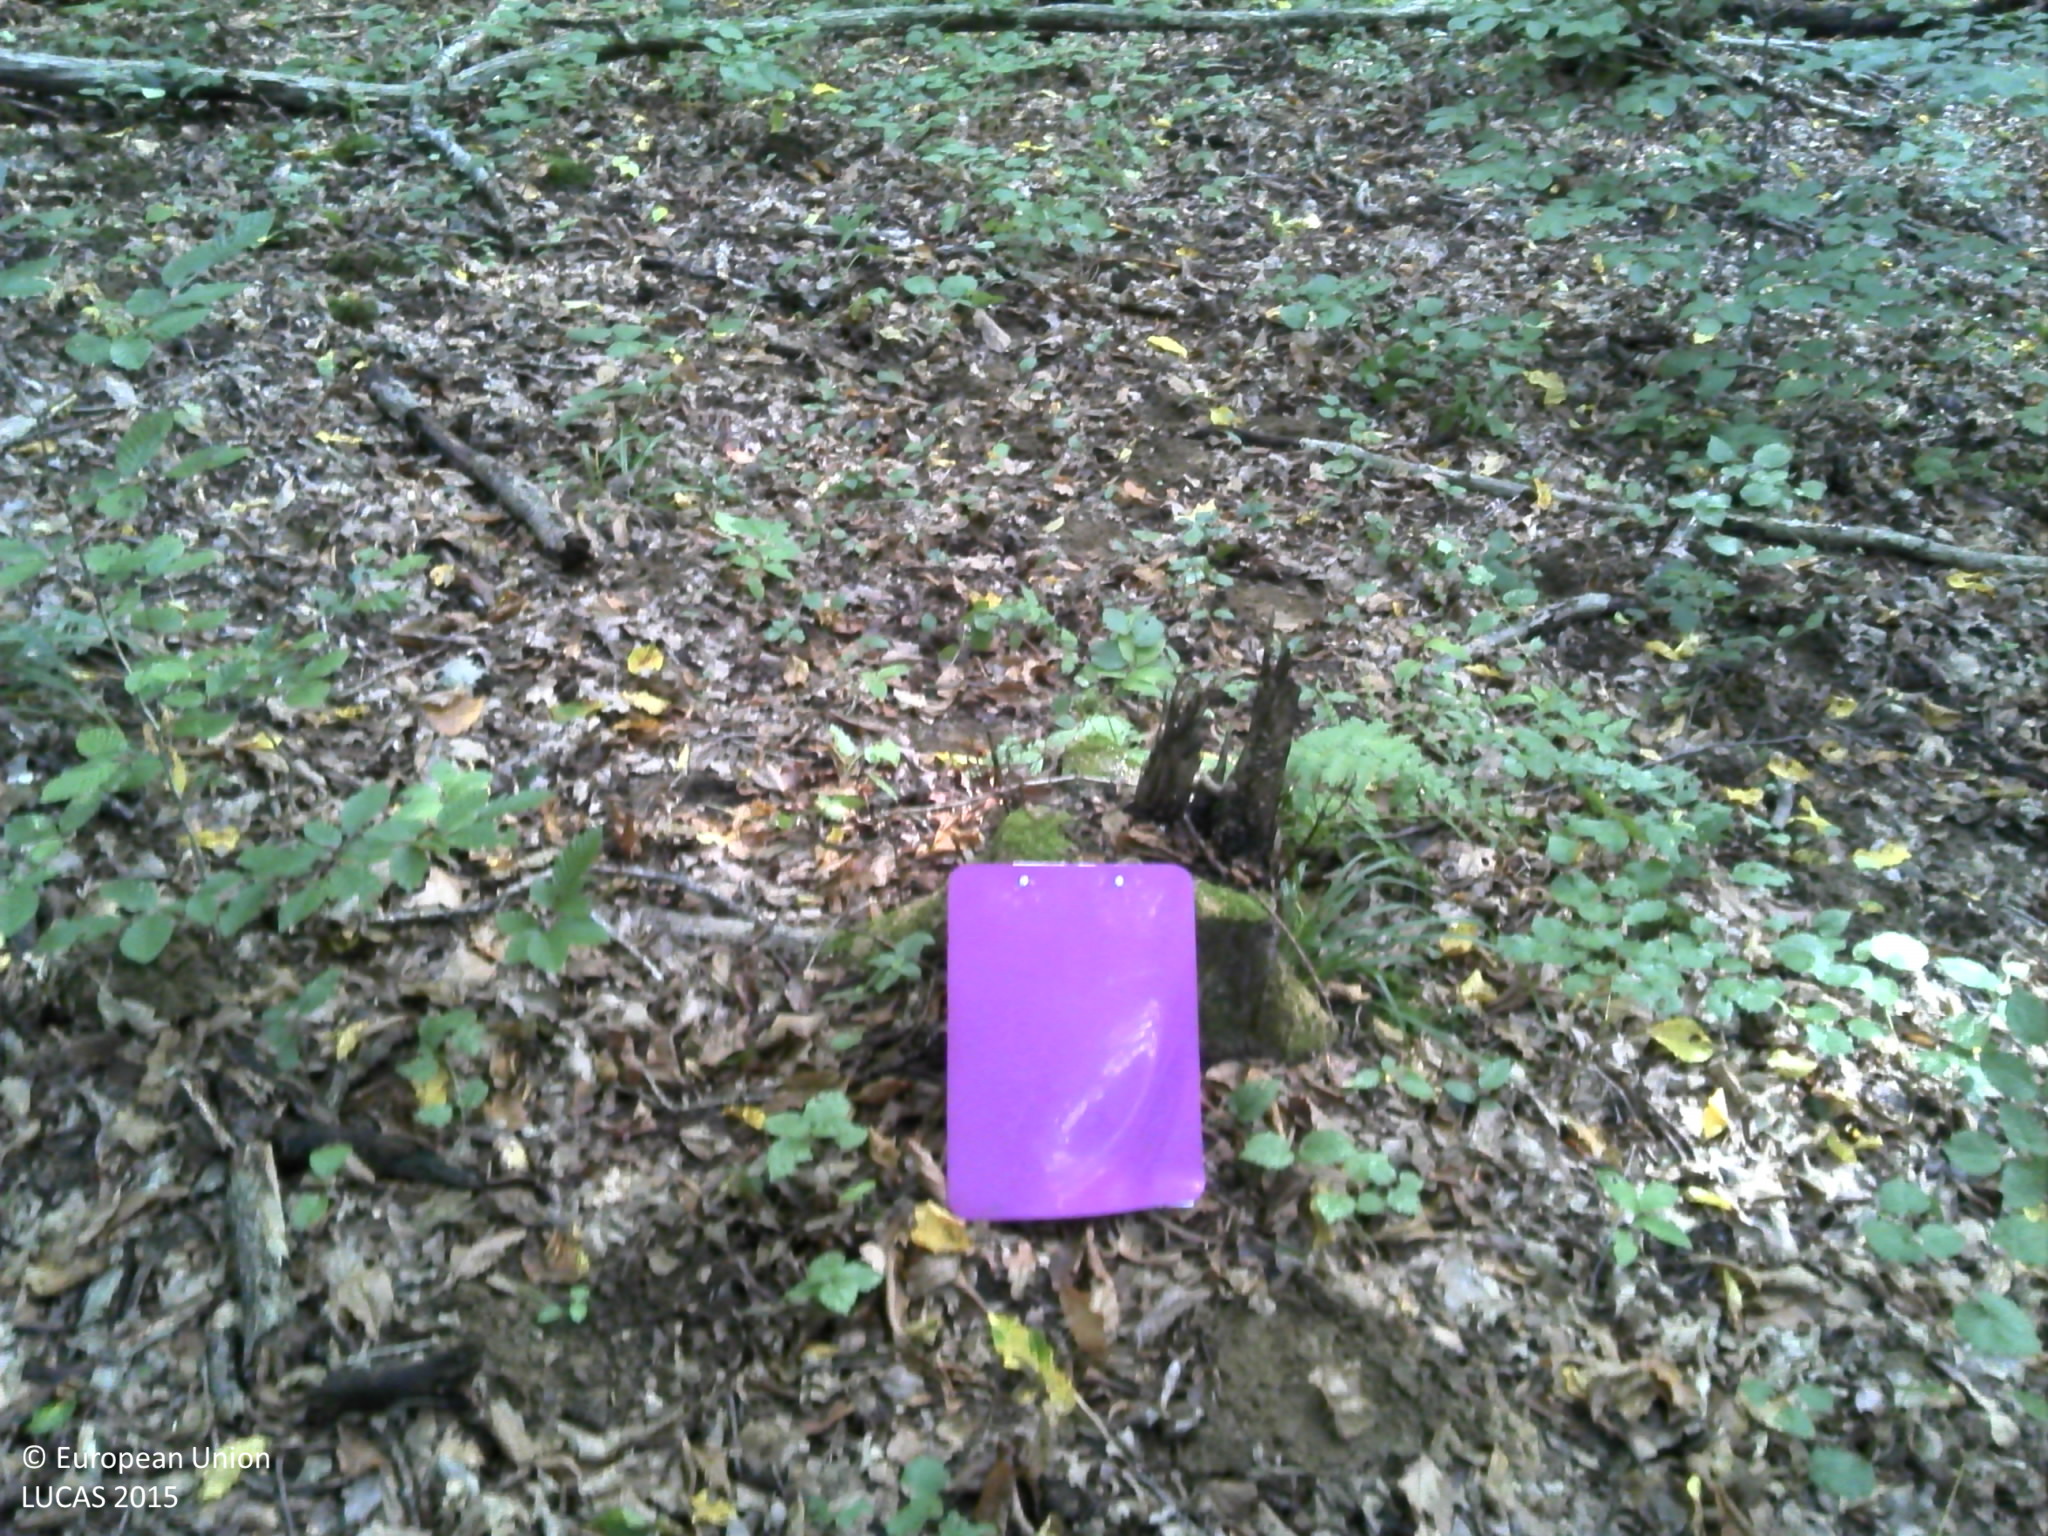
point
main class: Woodland
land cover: Broadleaved woodland
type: beech forest
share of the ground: > 75 %
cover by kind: broadleaved forest trees 100 %
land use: Forestry
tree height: > 5 m
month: August
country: HR
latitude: 45.2202
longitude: 16.6835
